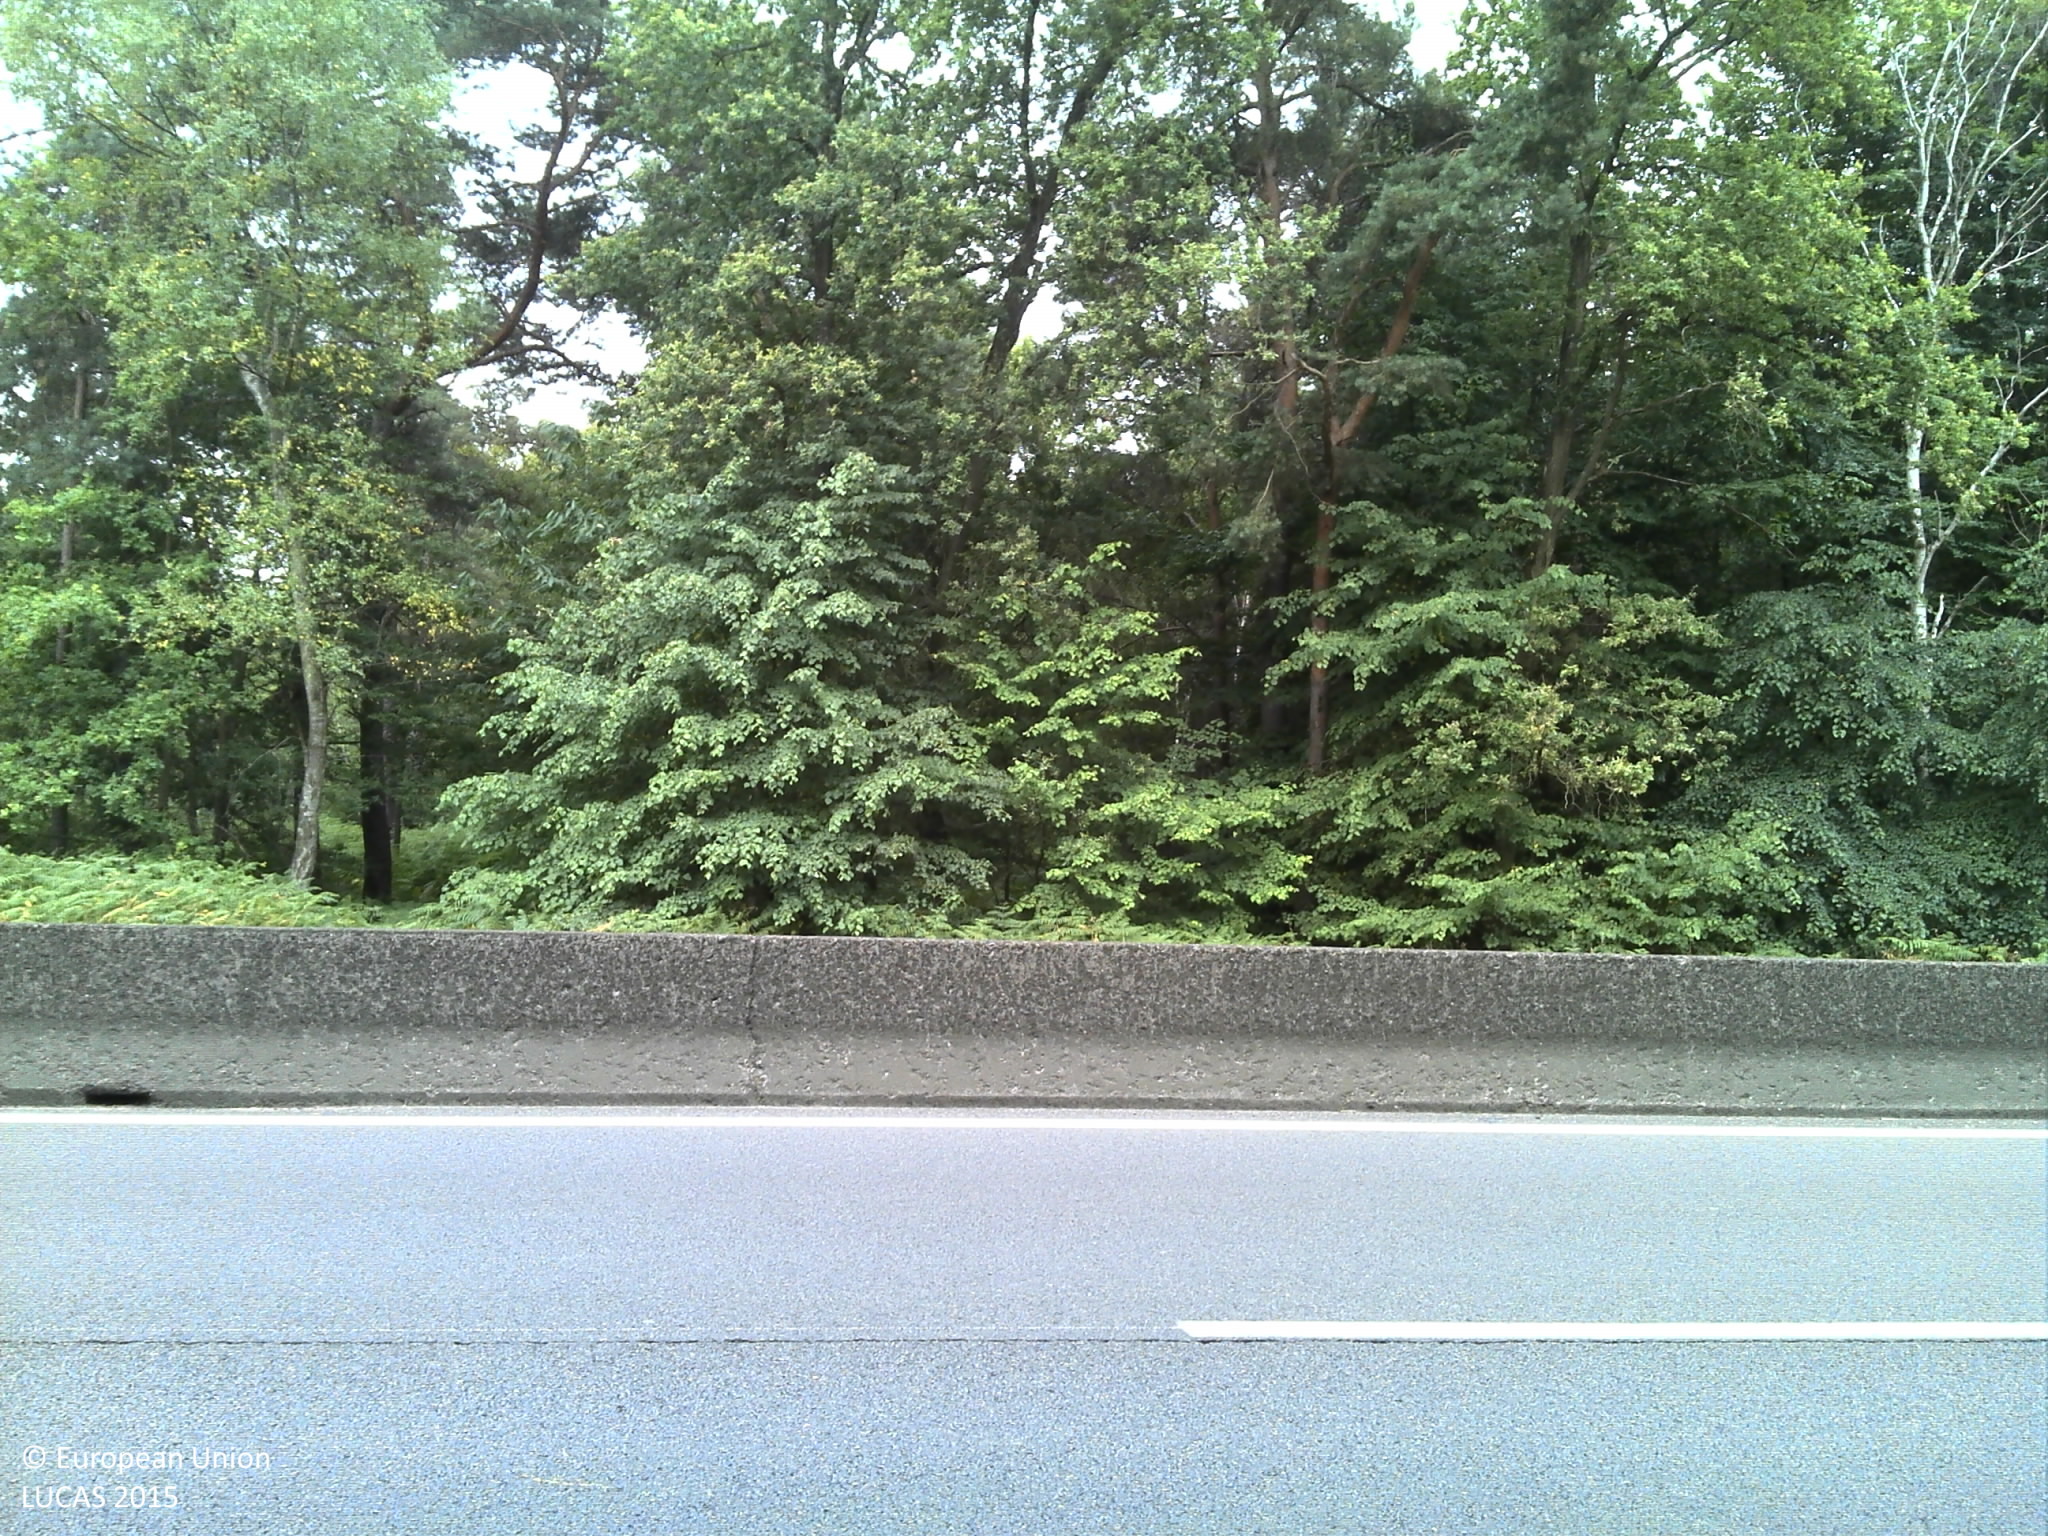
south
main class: Woodland
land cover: Pine dominated mixed woodland
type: hemiboreal forest and nemoral coniferous forest and mixed broadleaved-coniferous forest
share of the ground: > 75 %
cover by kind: broadleaved forest trees 55 %, coniferous forest trees 35 %, herbaceous plants 10 %
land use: Forestry
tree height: > 5 m
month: July
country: FR
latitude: 48.6891
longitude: 2.4768
